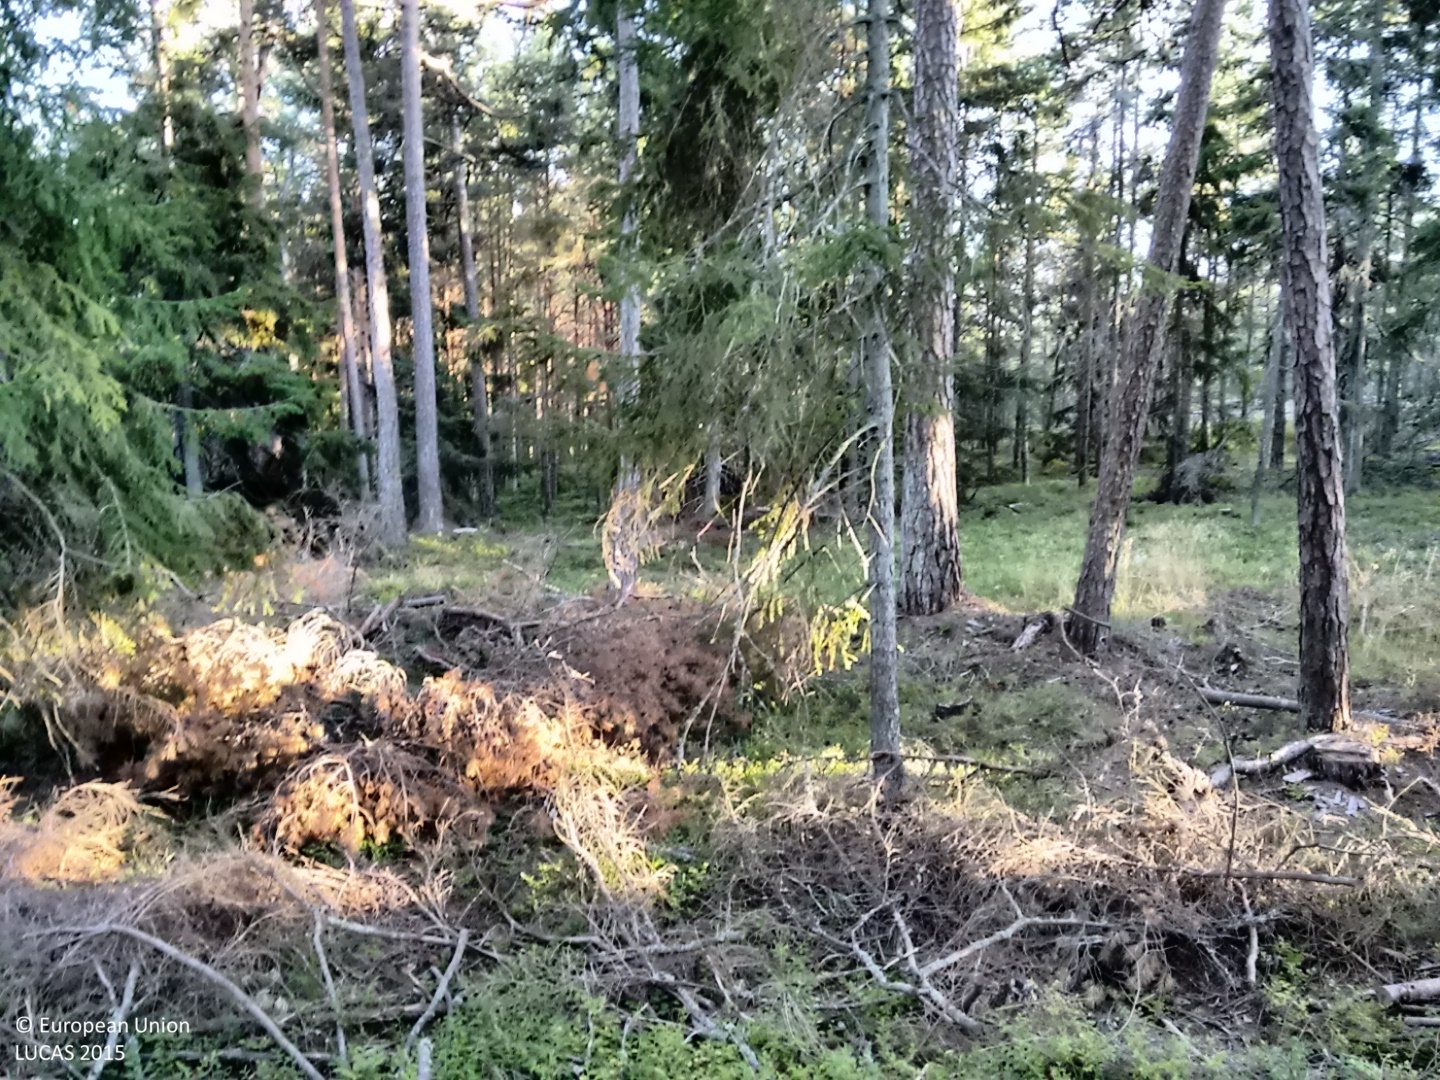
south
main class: Woodland
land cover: Pine dominated coniferous woodland
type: hemiboreal forest and nemoral coniferous forest and mixed broadleaved-coniferous forest
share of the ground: > 75 %
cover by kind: coniferous forest trees 90 %, shrubs 10 %
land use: Forestry
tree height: > 5 m
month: August
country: FI
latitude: 60.1157
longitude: 19.9934
